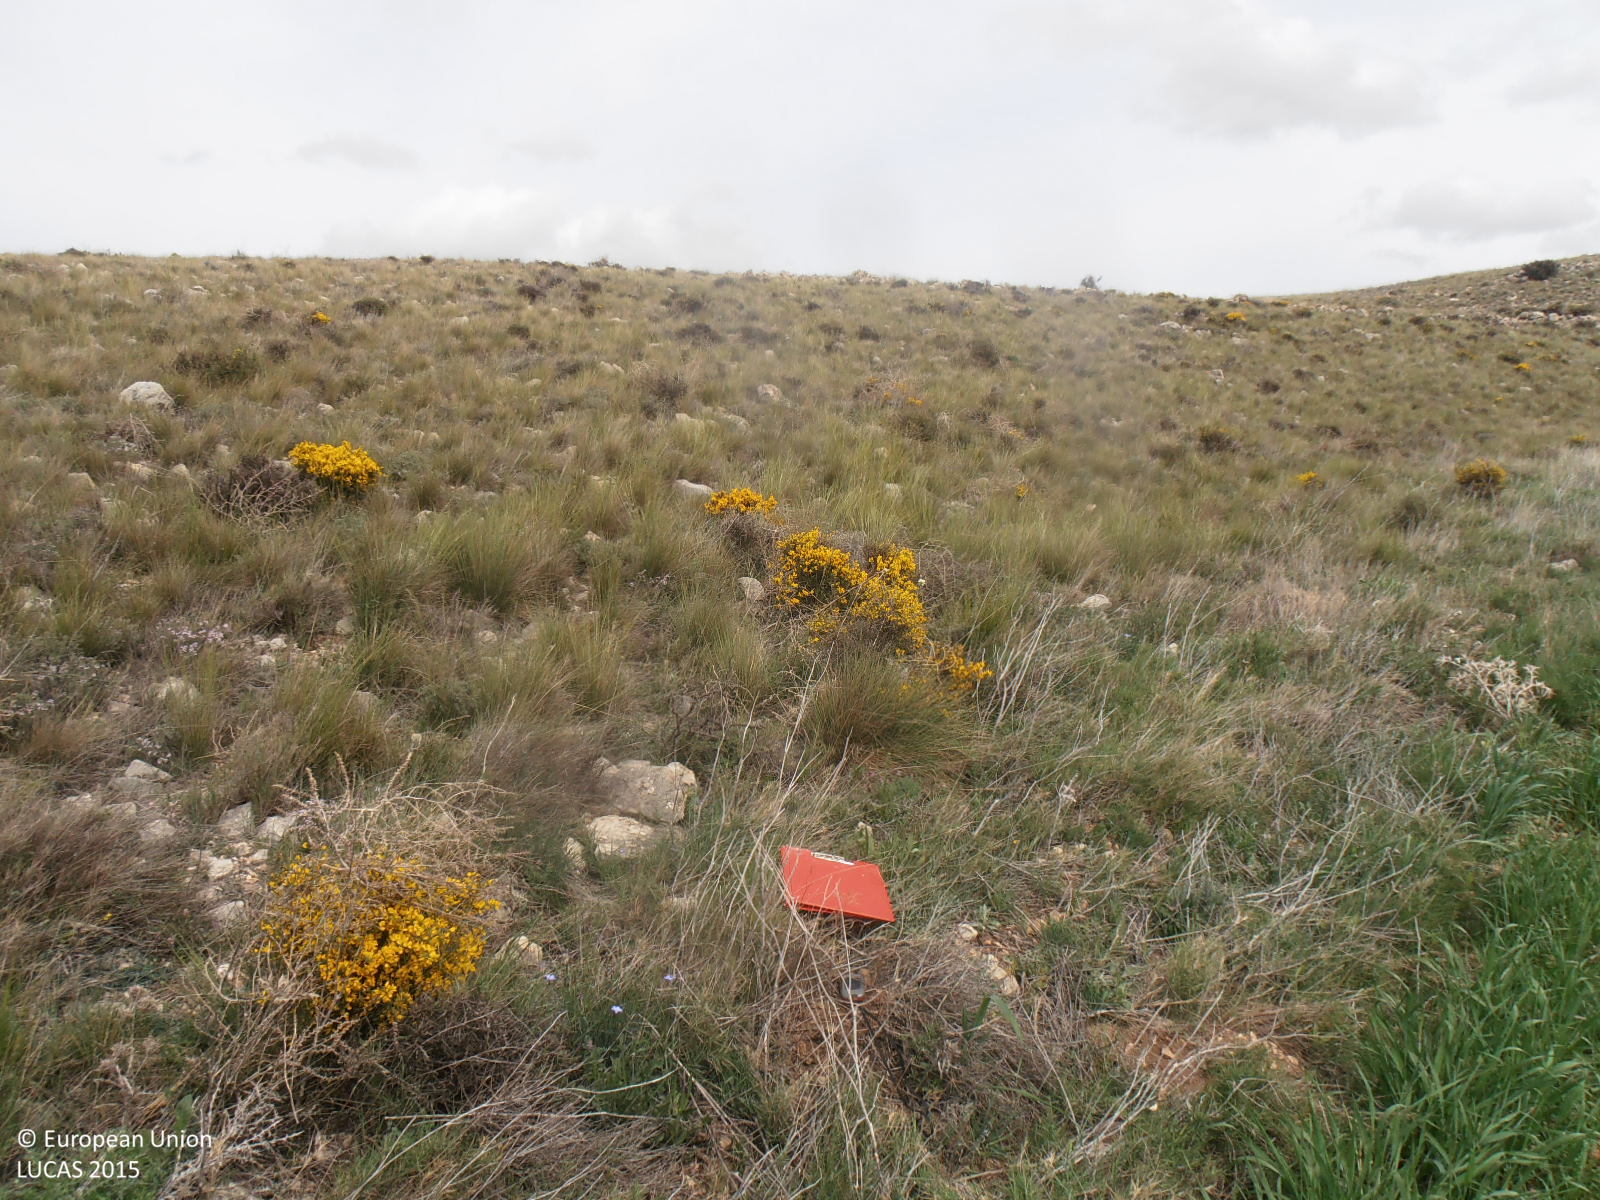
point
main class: Shrubland
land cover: Shrubland without tree cover
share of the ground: > 75 %
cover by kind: shrubs 60 %, consolidated bare surface 30 %, herbaceous plants 10 %
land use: Semi-natural and natural areas not in use
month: April
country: ES
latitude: 41.0948
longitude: -0.9343
